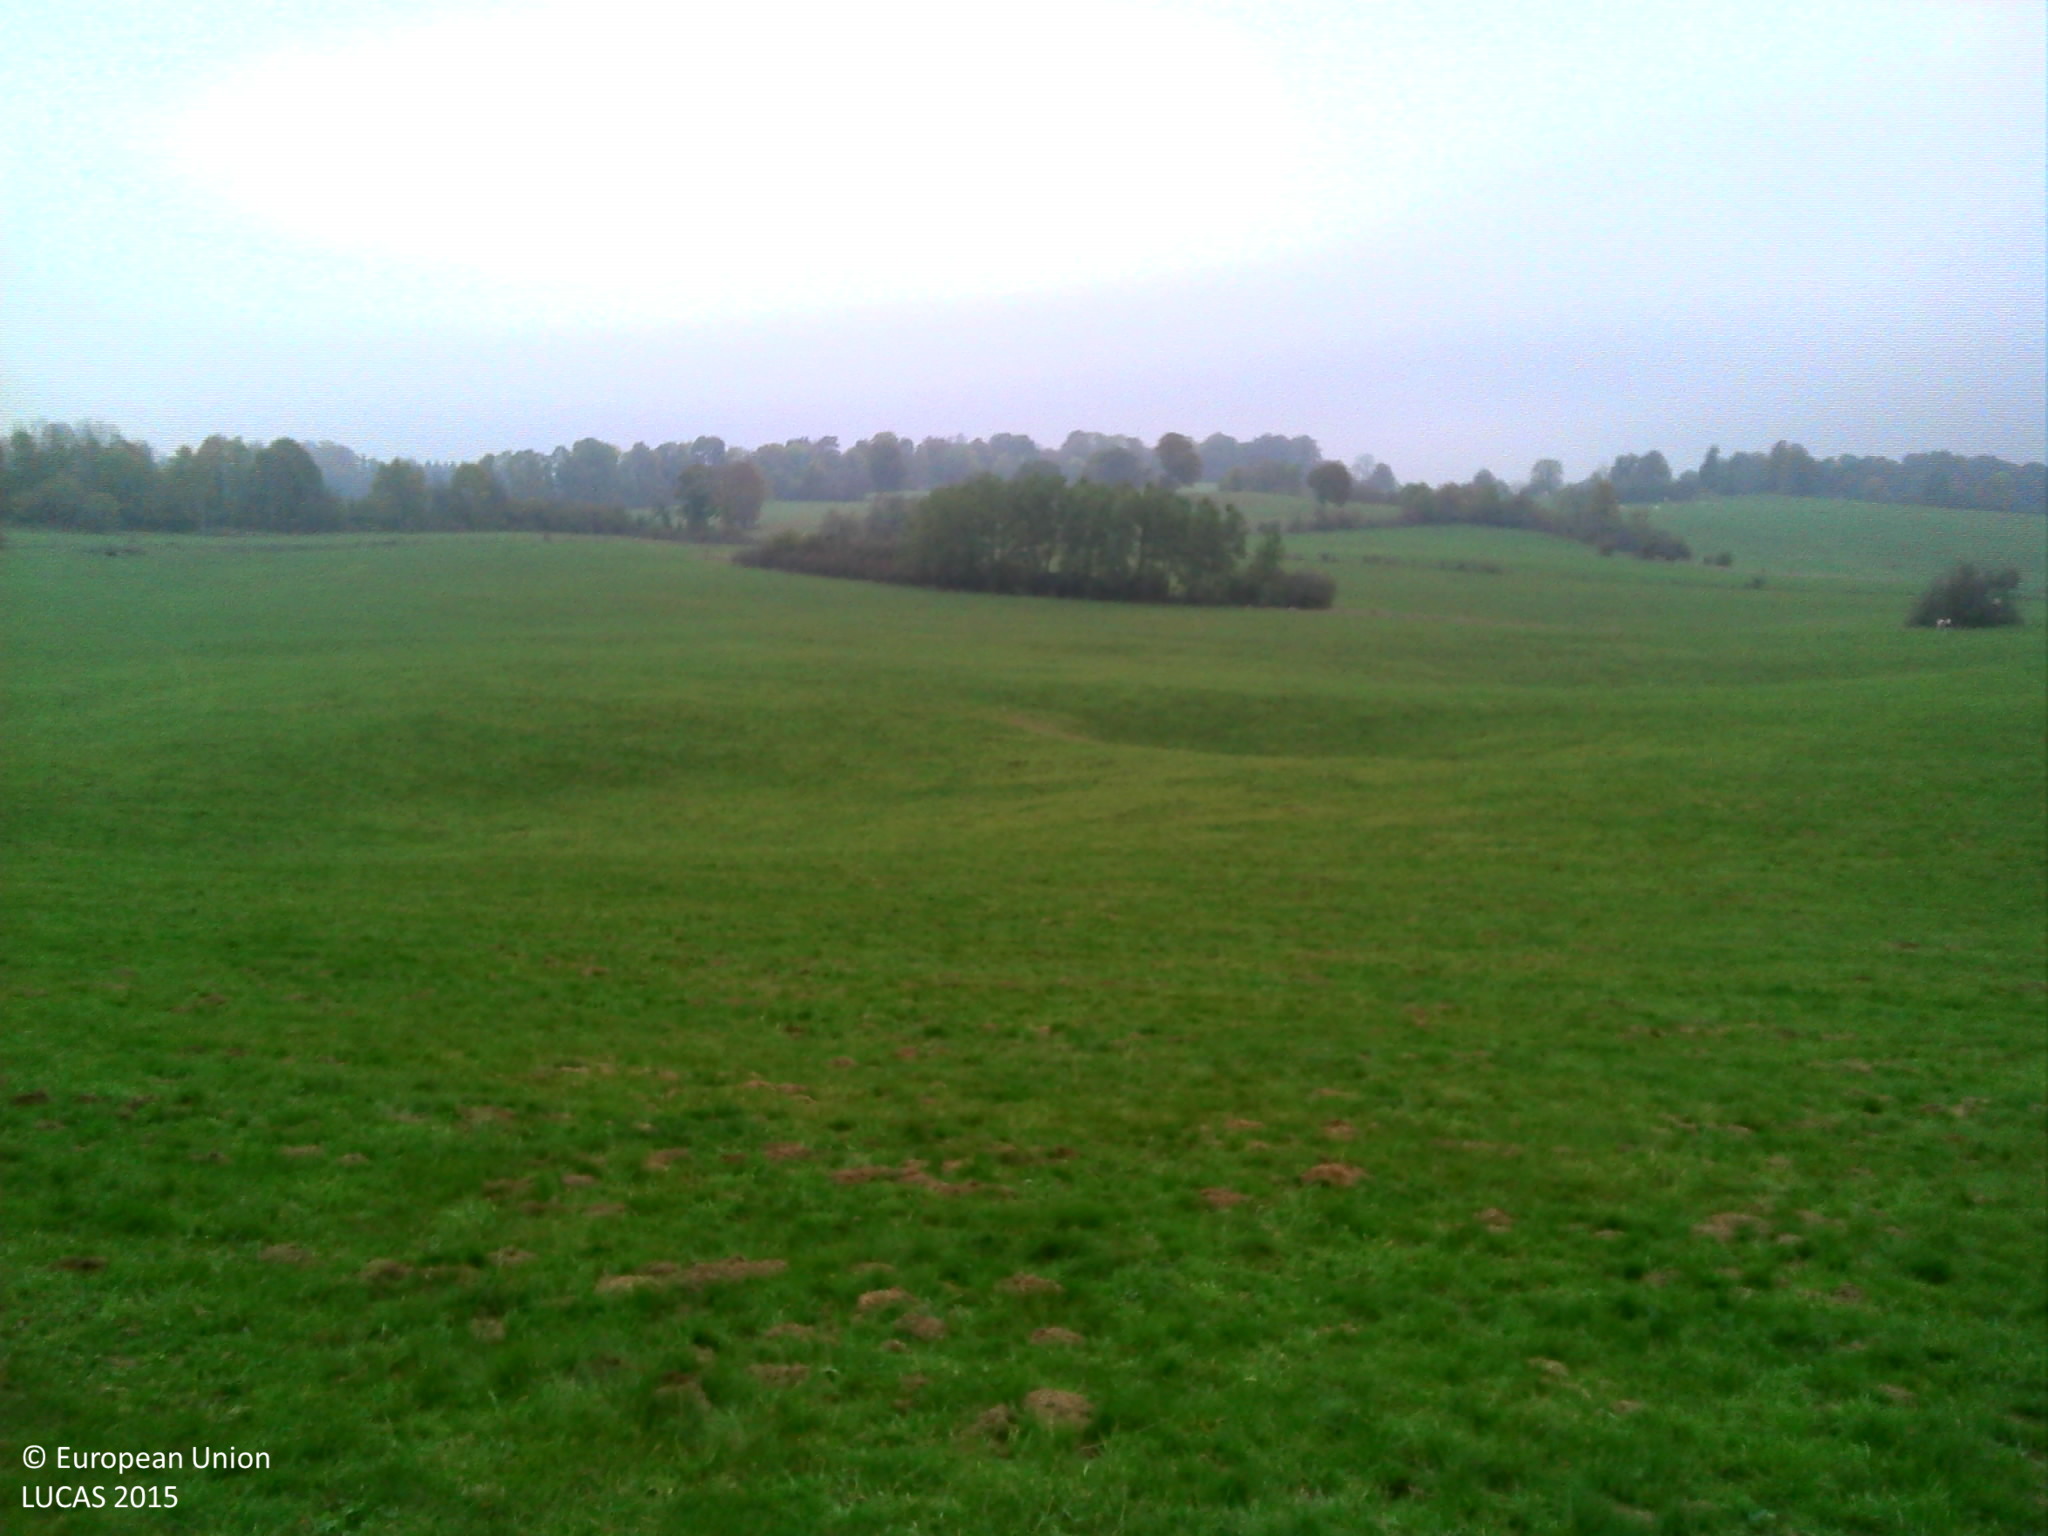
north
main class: Grassland
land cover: Grassland without tree/shrub cover
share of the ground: > 75 %
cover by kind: herbaceous plants 100 %
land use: Agriculture (excluding fallow land and kitchen gardens)
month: October
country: FR
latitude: 46.9131
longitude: 6.1553
